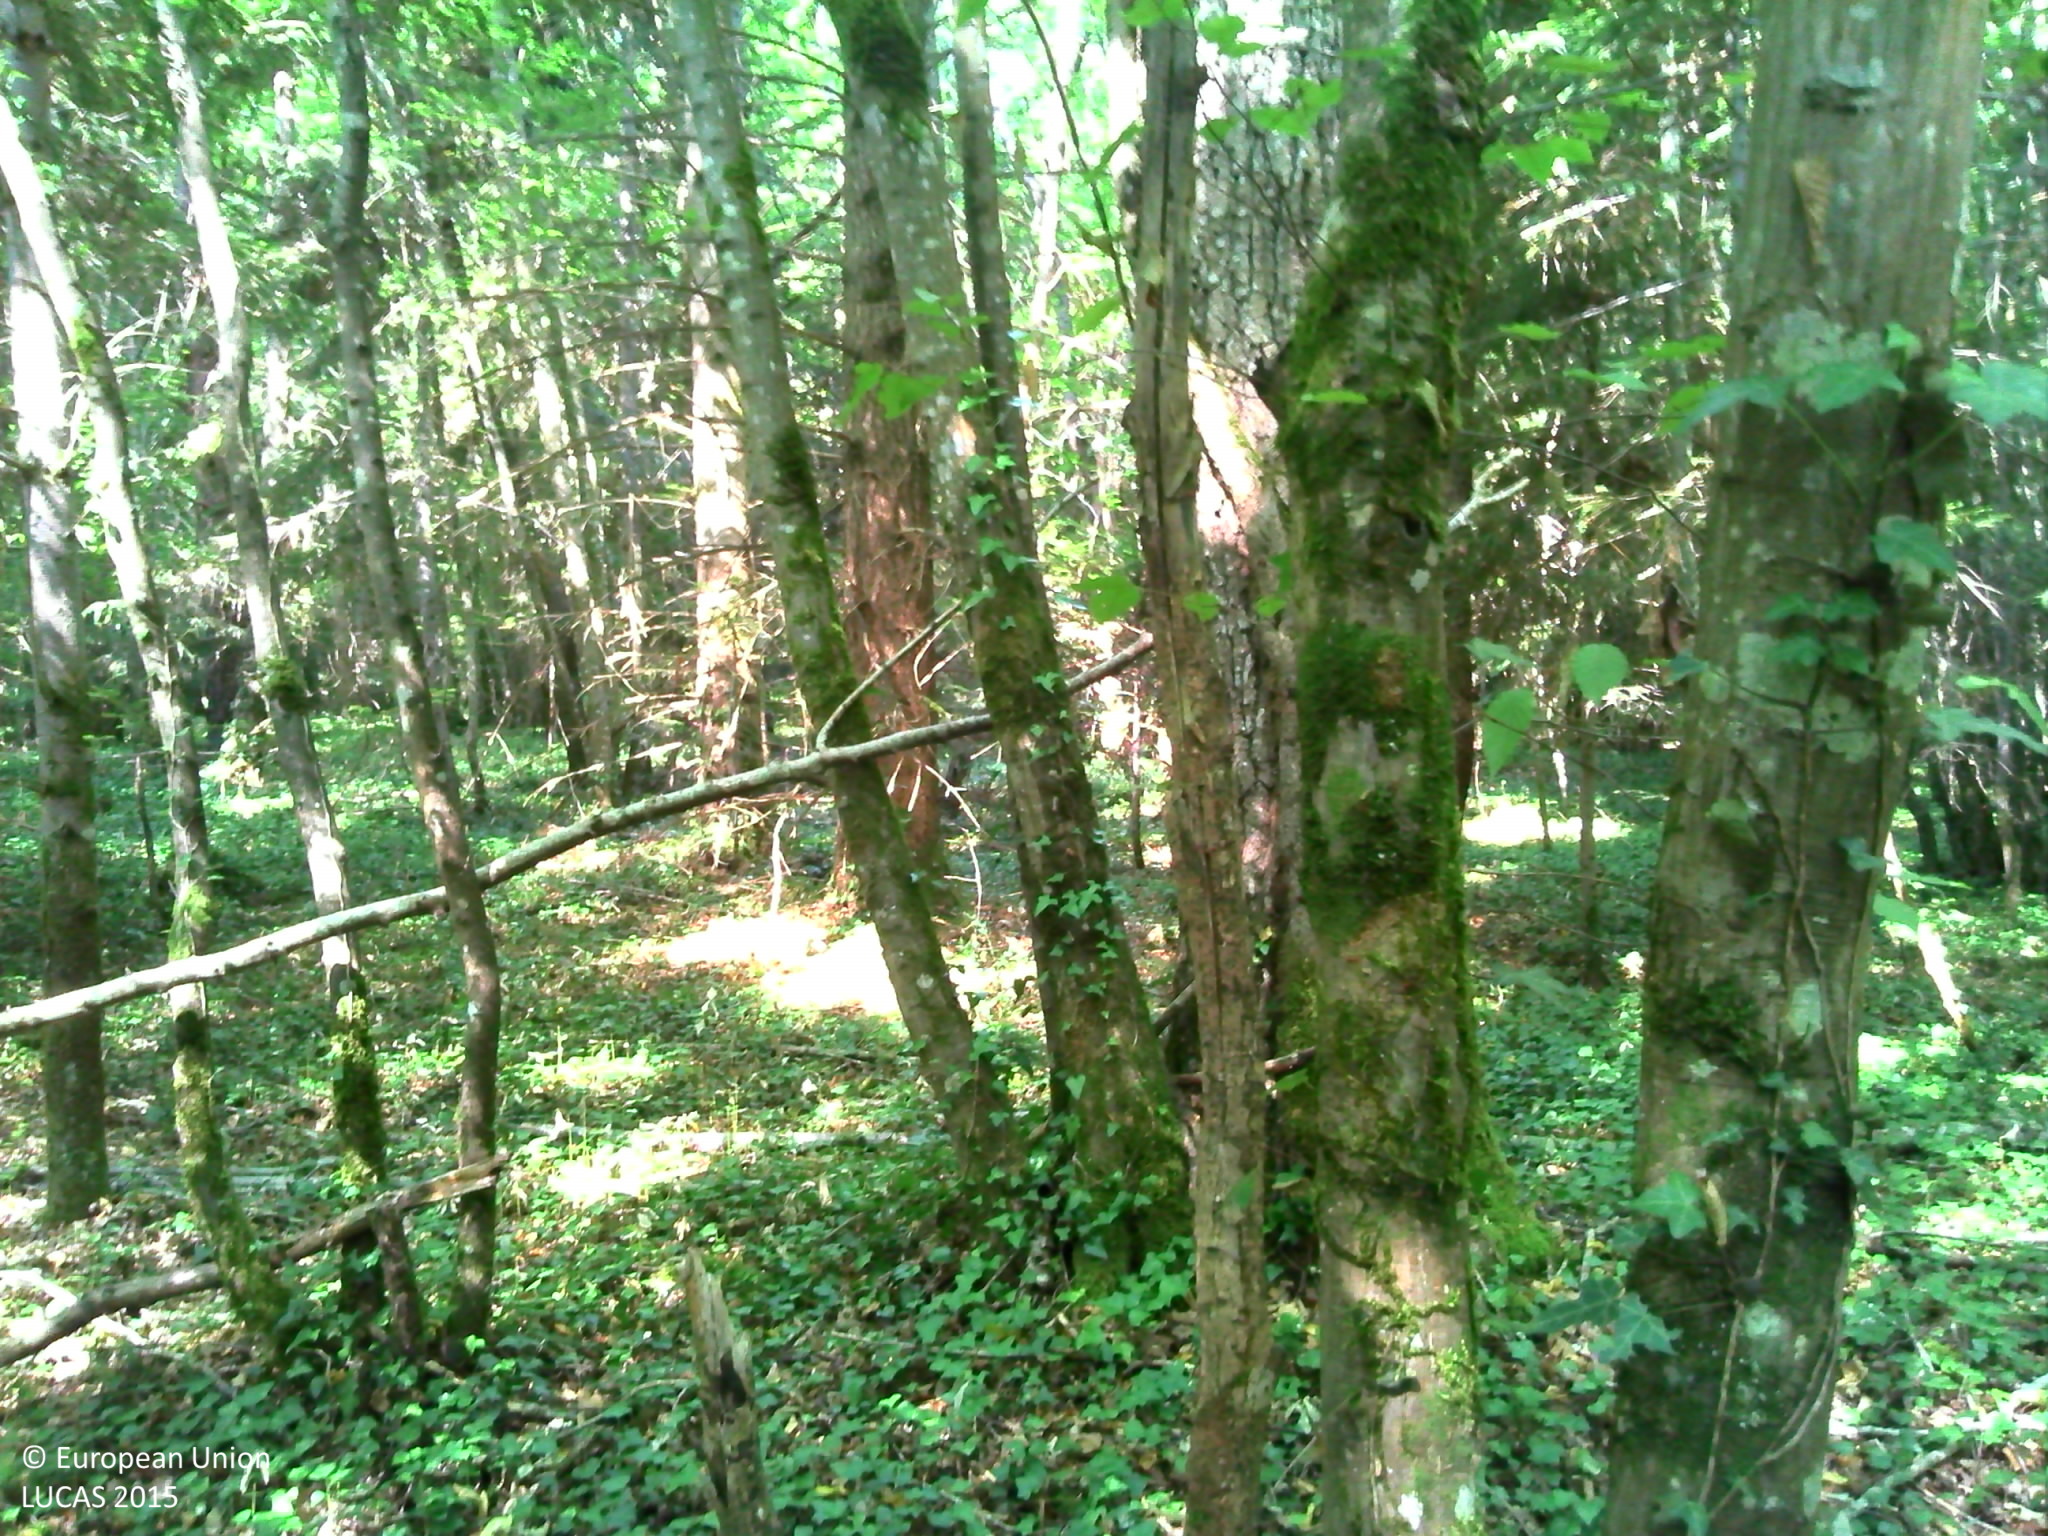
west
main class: Woodland
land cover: Pine dominated coniferous woodland
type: hemiboreal forest and nemoral coniferous forest and mixed broadleaved-coniferous forest
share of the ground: > 75 %
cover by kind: coniferous forest trees 80 %, herbaceous plants 10 %, shrubs 5 %, lichens and mosses 5 %
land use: Forestry
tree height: > 5 m
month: August
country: FR
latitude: 44.7716
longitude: 0.7557
